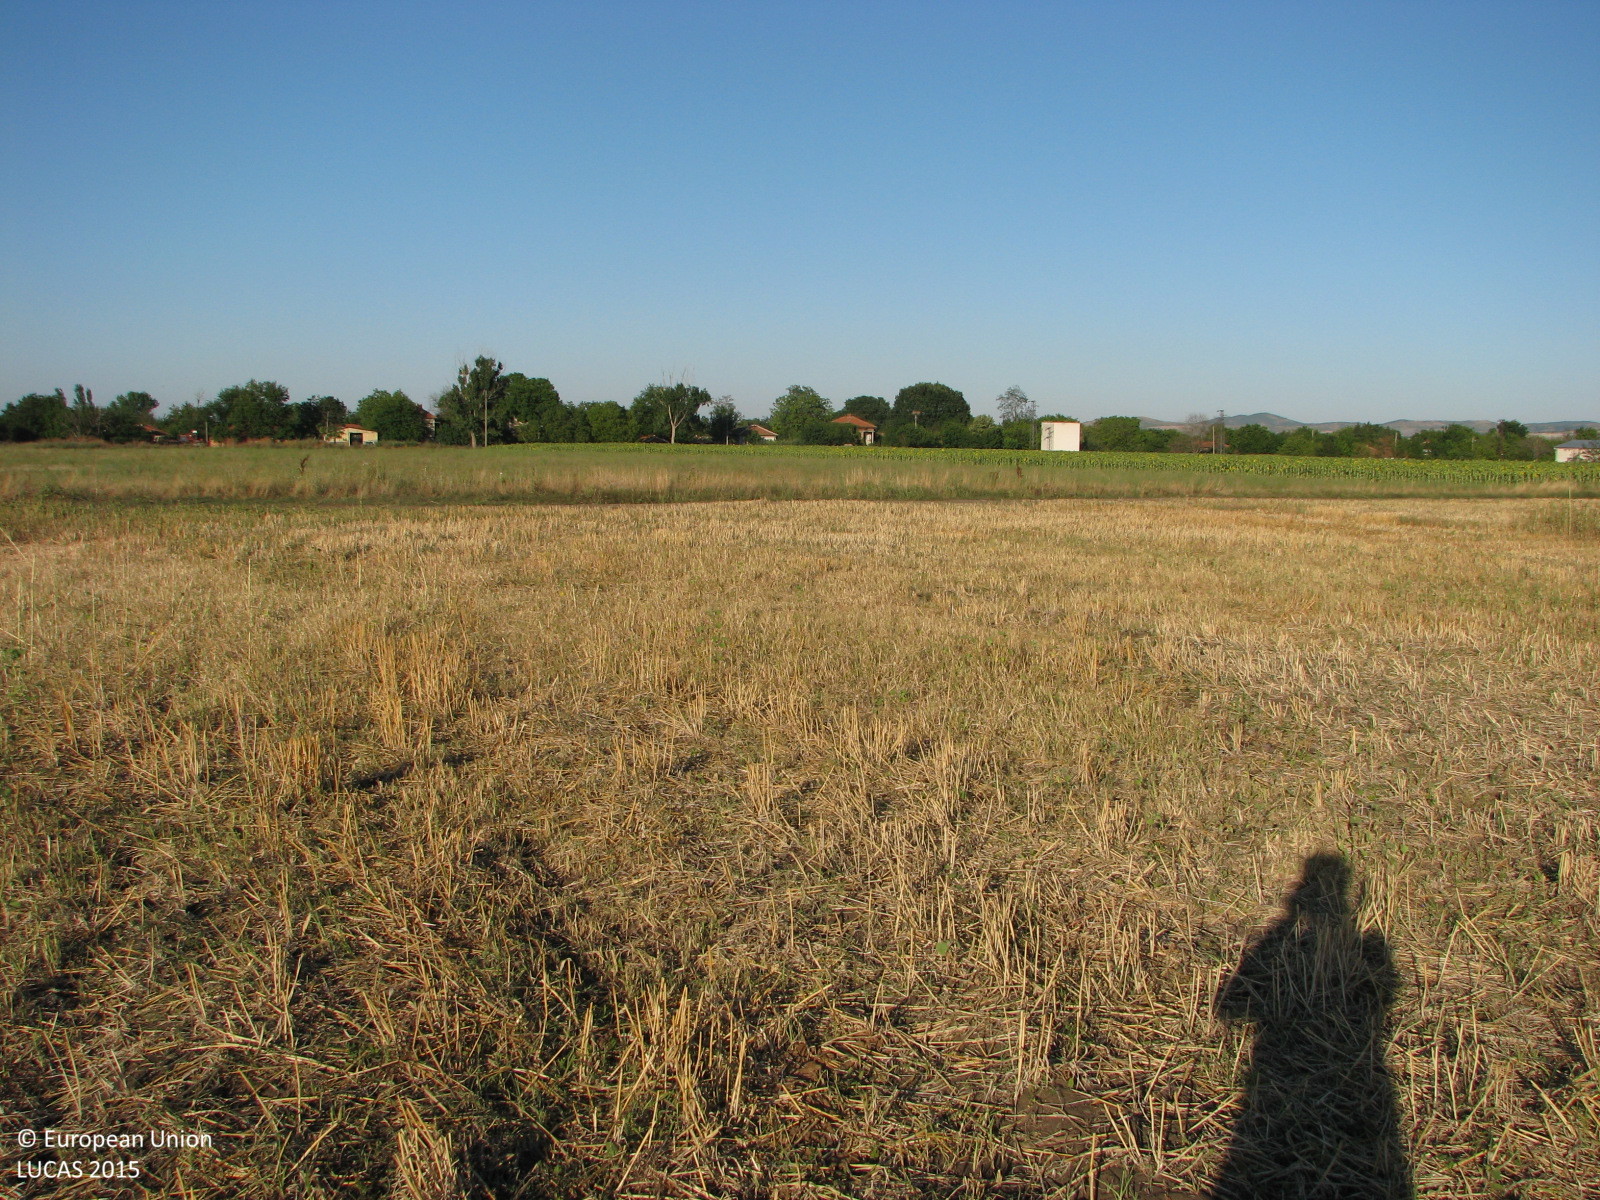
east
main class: Cropland
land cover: Common wheat
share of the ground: 10 - 25 %
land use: Agriculture (excluding fallow land and kitchen gardens)
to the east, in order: Common wheat; Tracks; Grass margins; Common wheat; Sunflower
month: July
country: BG
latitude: 42.4607
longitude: 25.9741
